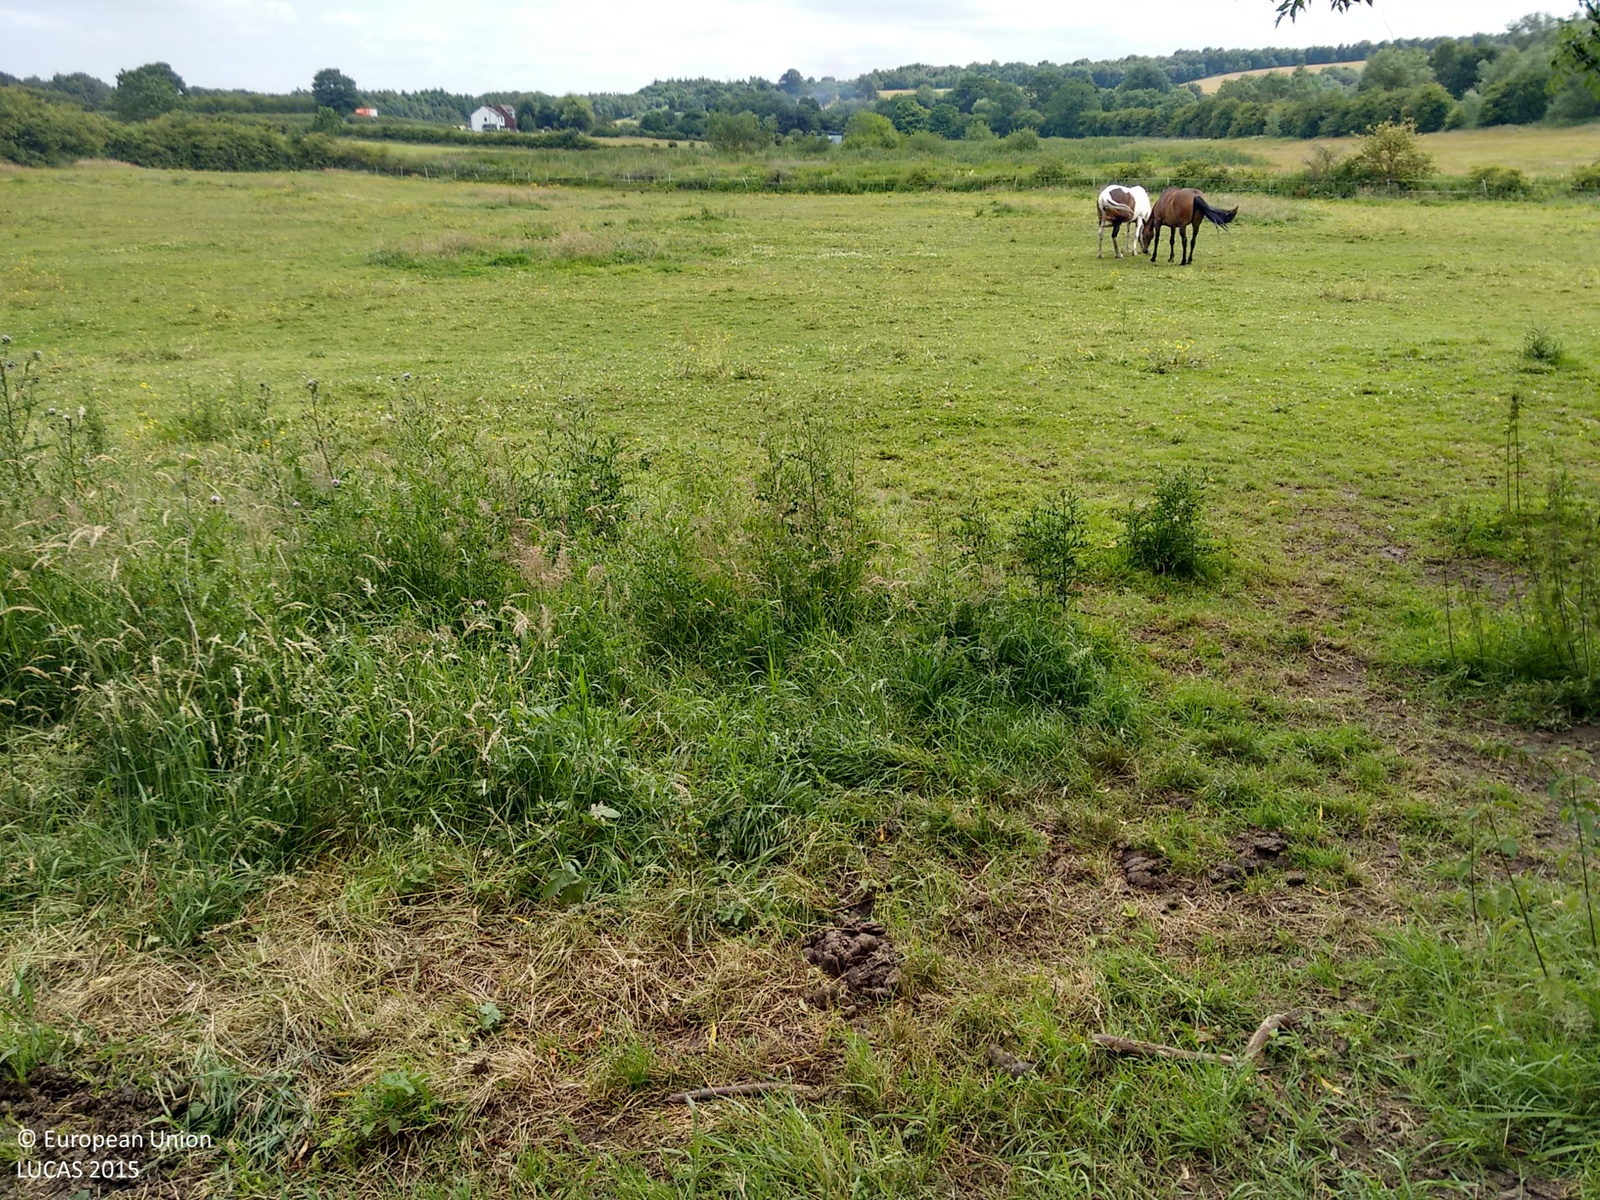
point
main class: Grassland
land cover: Grassland without tree/shrub cover
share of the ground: > 75 %
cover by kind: herbaceous plants 100 %
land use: Agriculture (excluding fallow land and kitchen gardens)
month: July
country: GB
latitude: 53.0581
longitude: -1.4341
